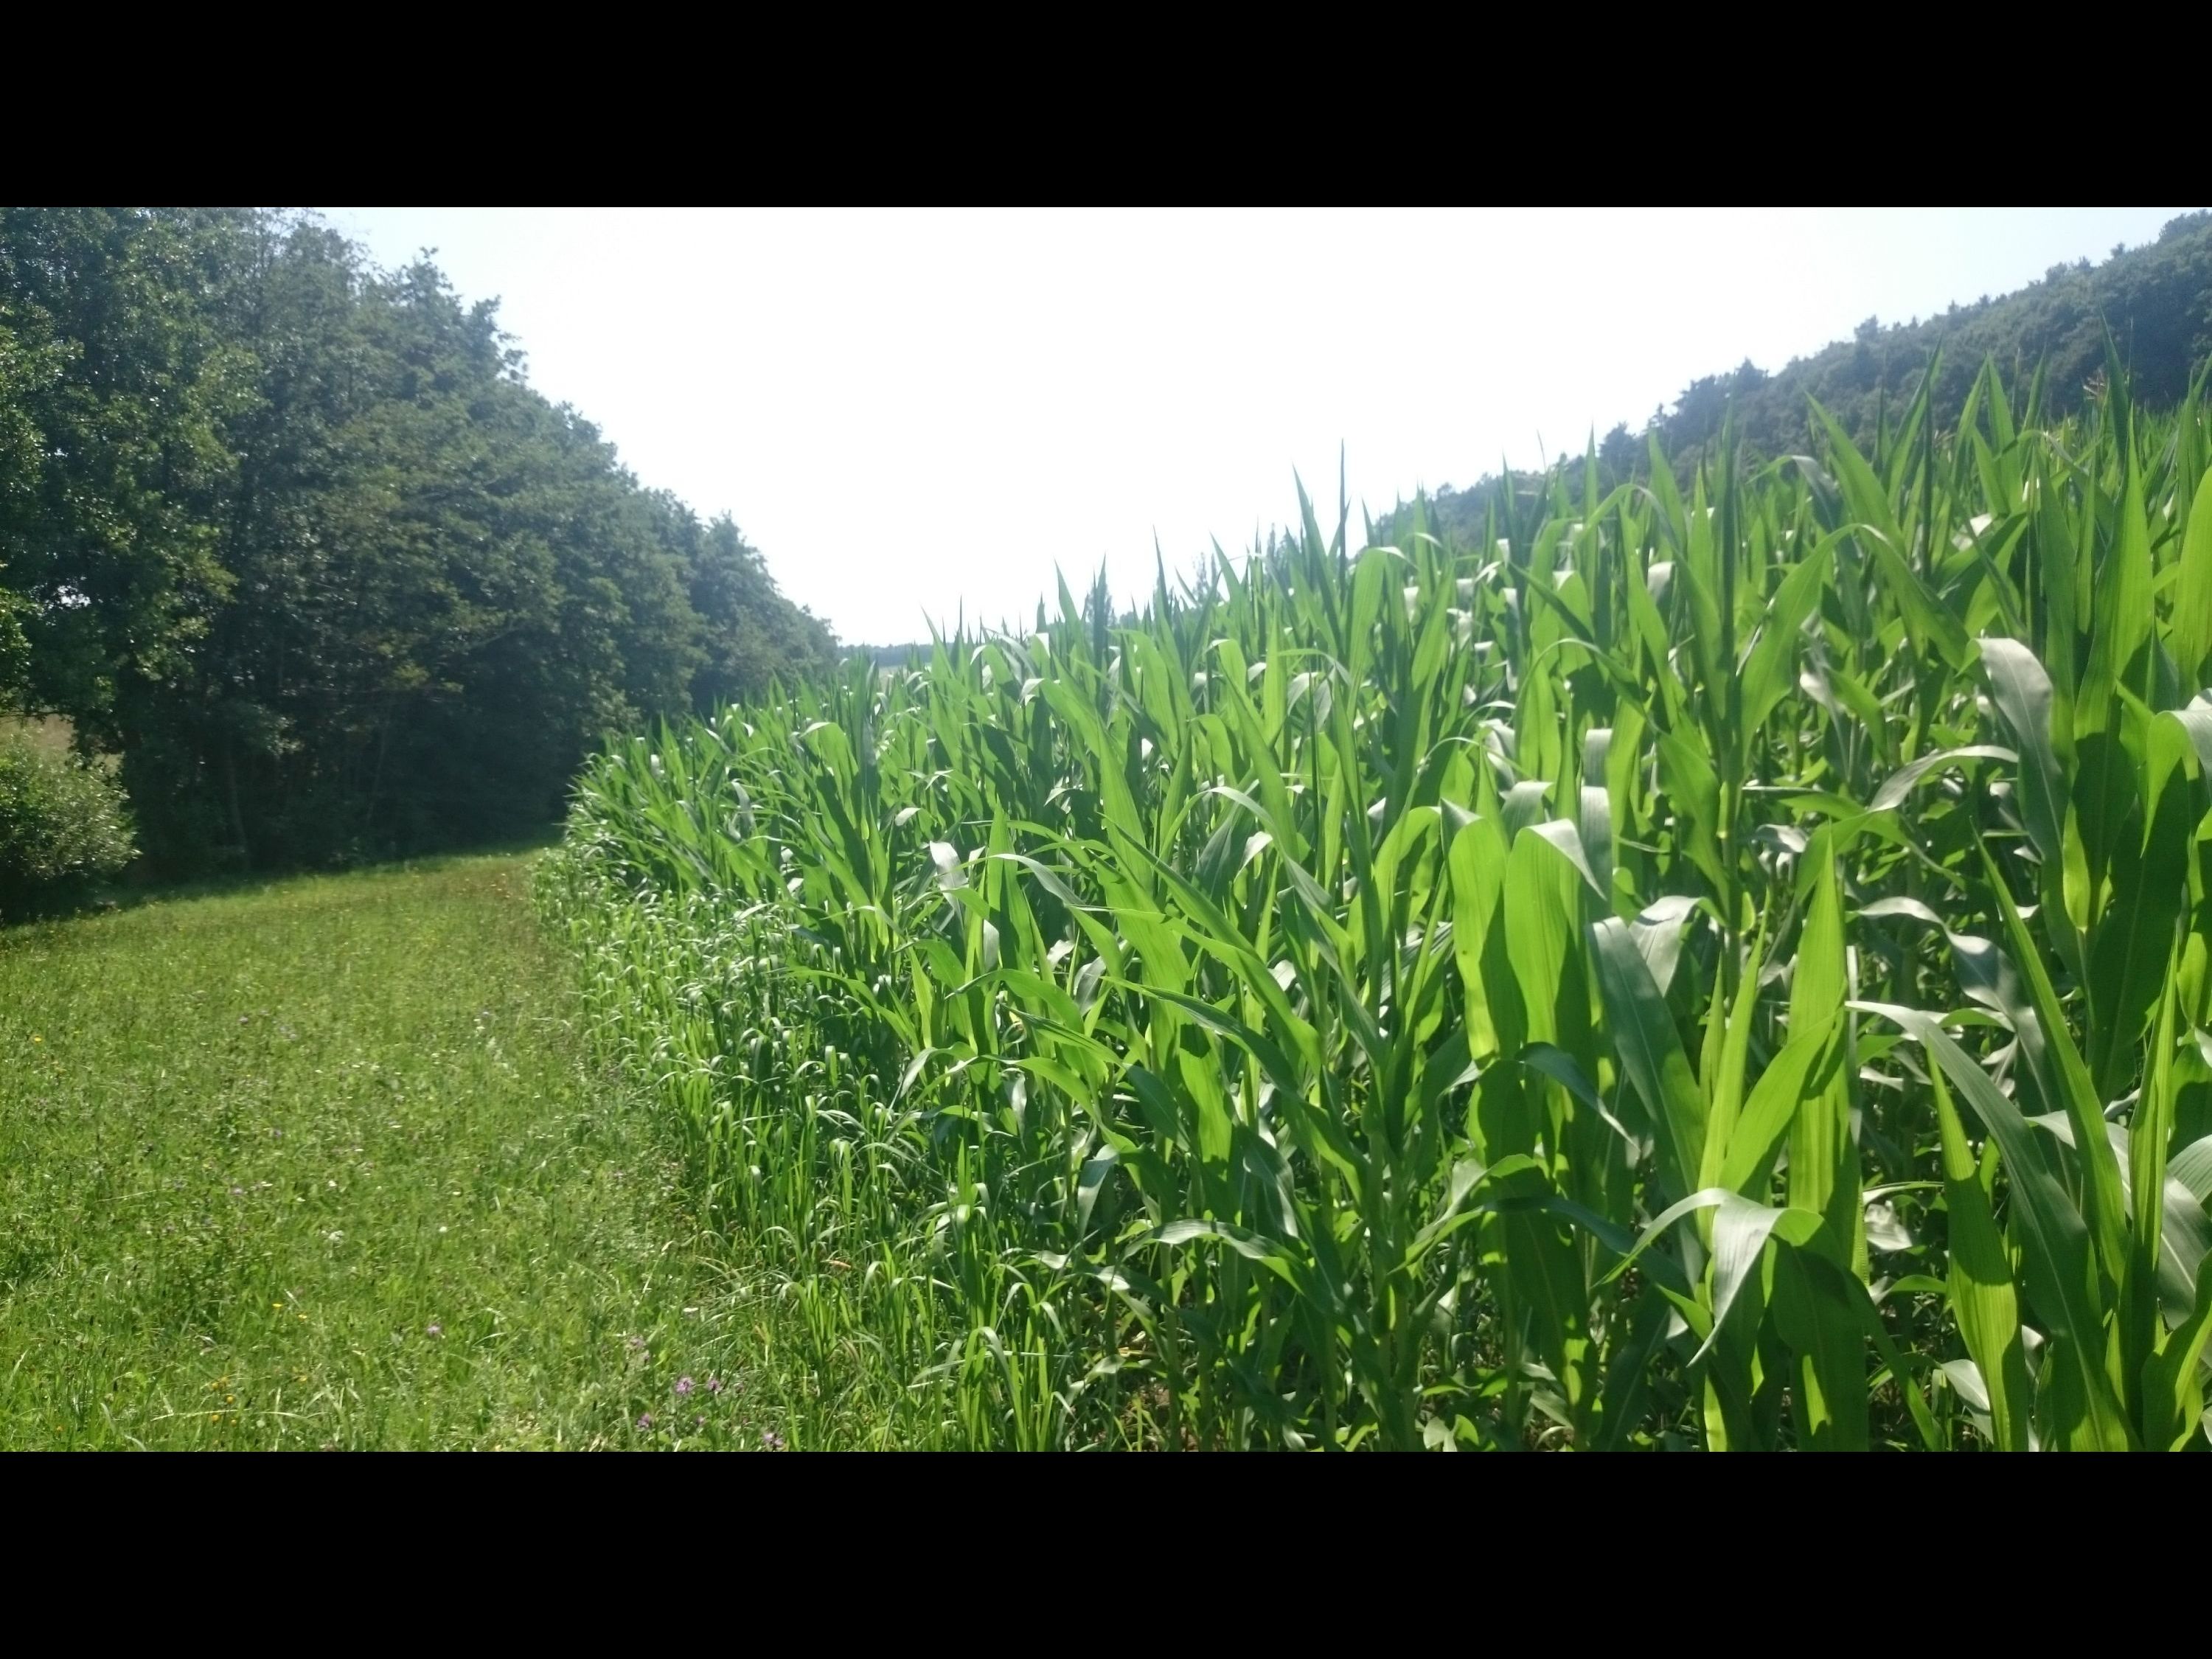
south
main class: Cropland
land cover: Maize
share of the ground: > 75 %
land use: Agriculture (excluding fallow land and kitchen gardens)
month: July
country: AT
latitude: 47.0471
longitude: 16.0429
